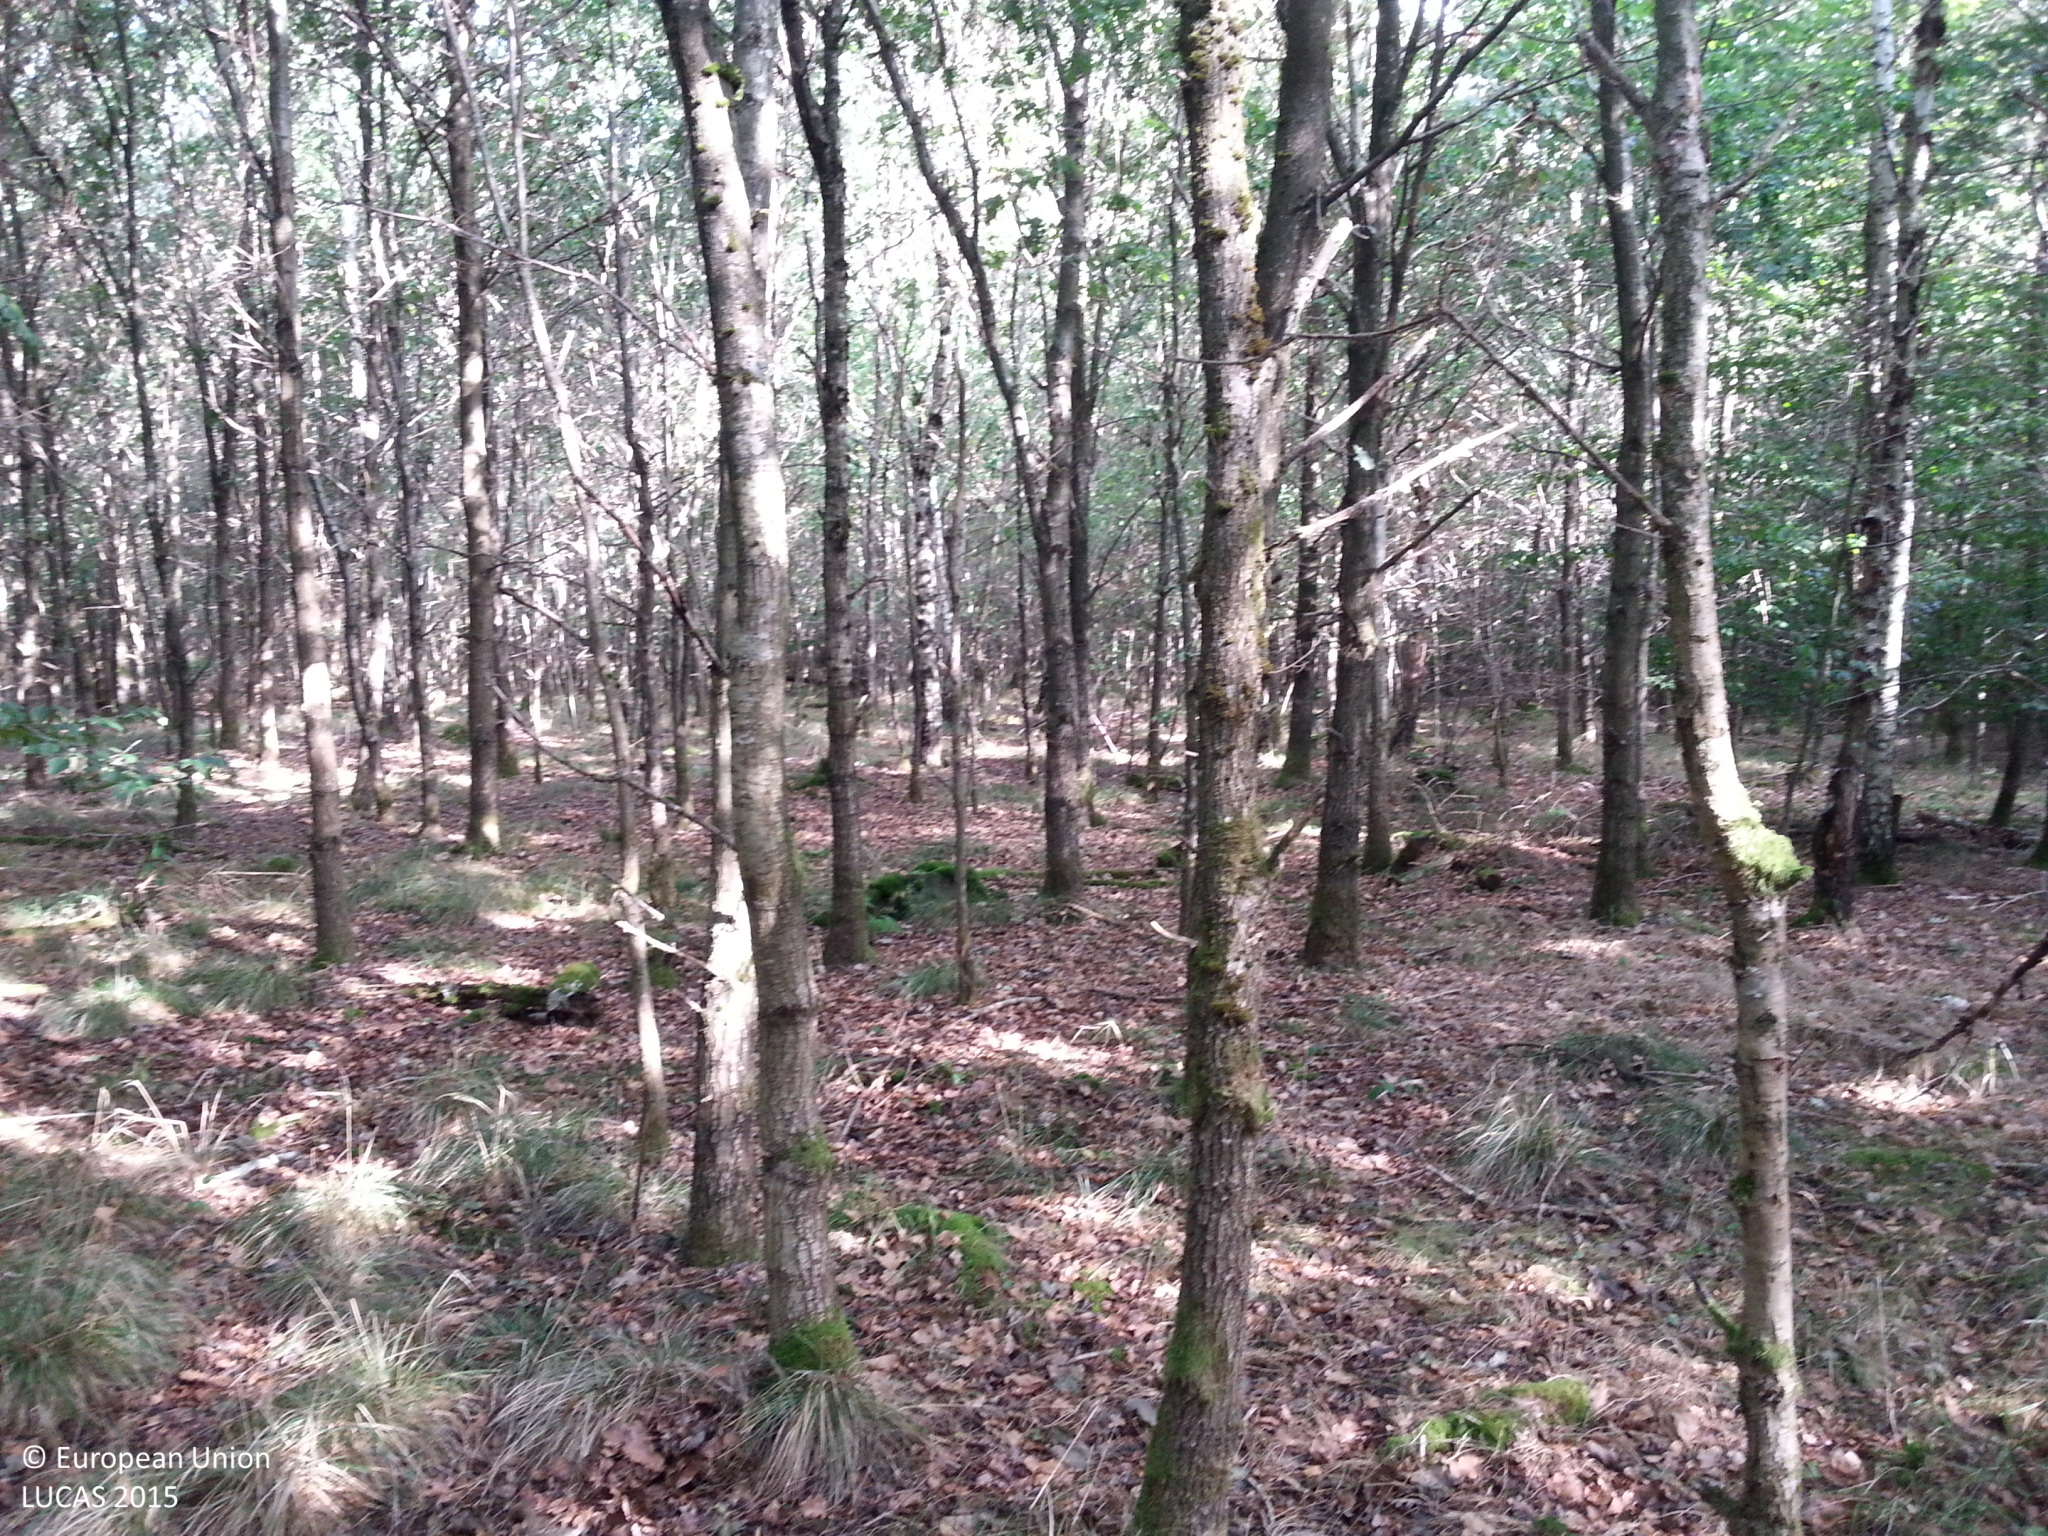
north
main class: Woodland
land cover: Broadleaved woodland
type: mesophytic deciduous forest
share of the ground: > 75 %
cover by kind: broadleaved forest trees 80 %, herbaceous plants 10 %, unconsolidated bare surface 10 %
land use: Forestry
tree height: > 5 m
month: September
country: DE
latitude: 49.6072
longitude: 9.4052
